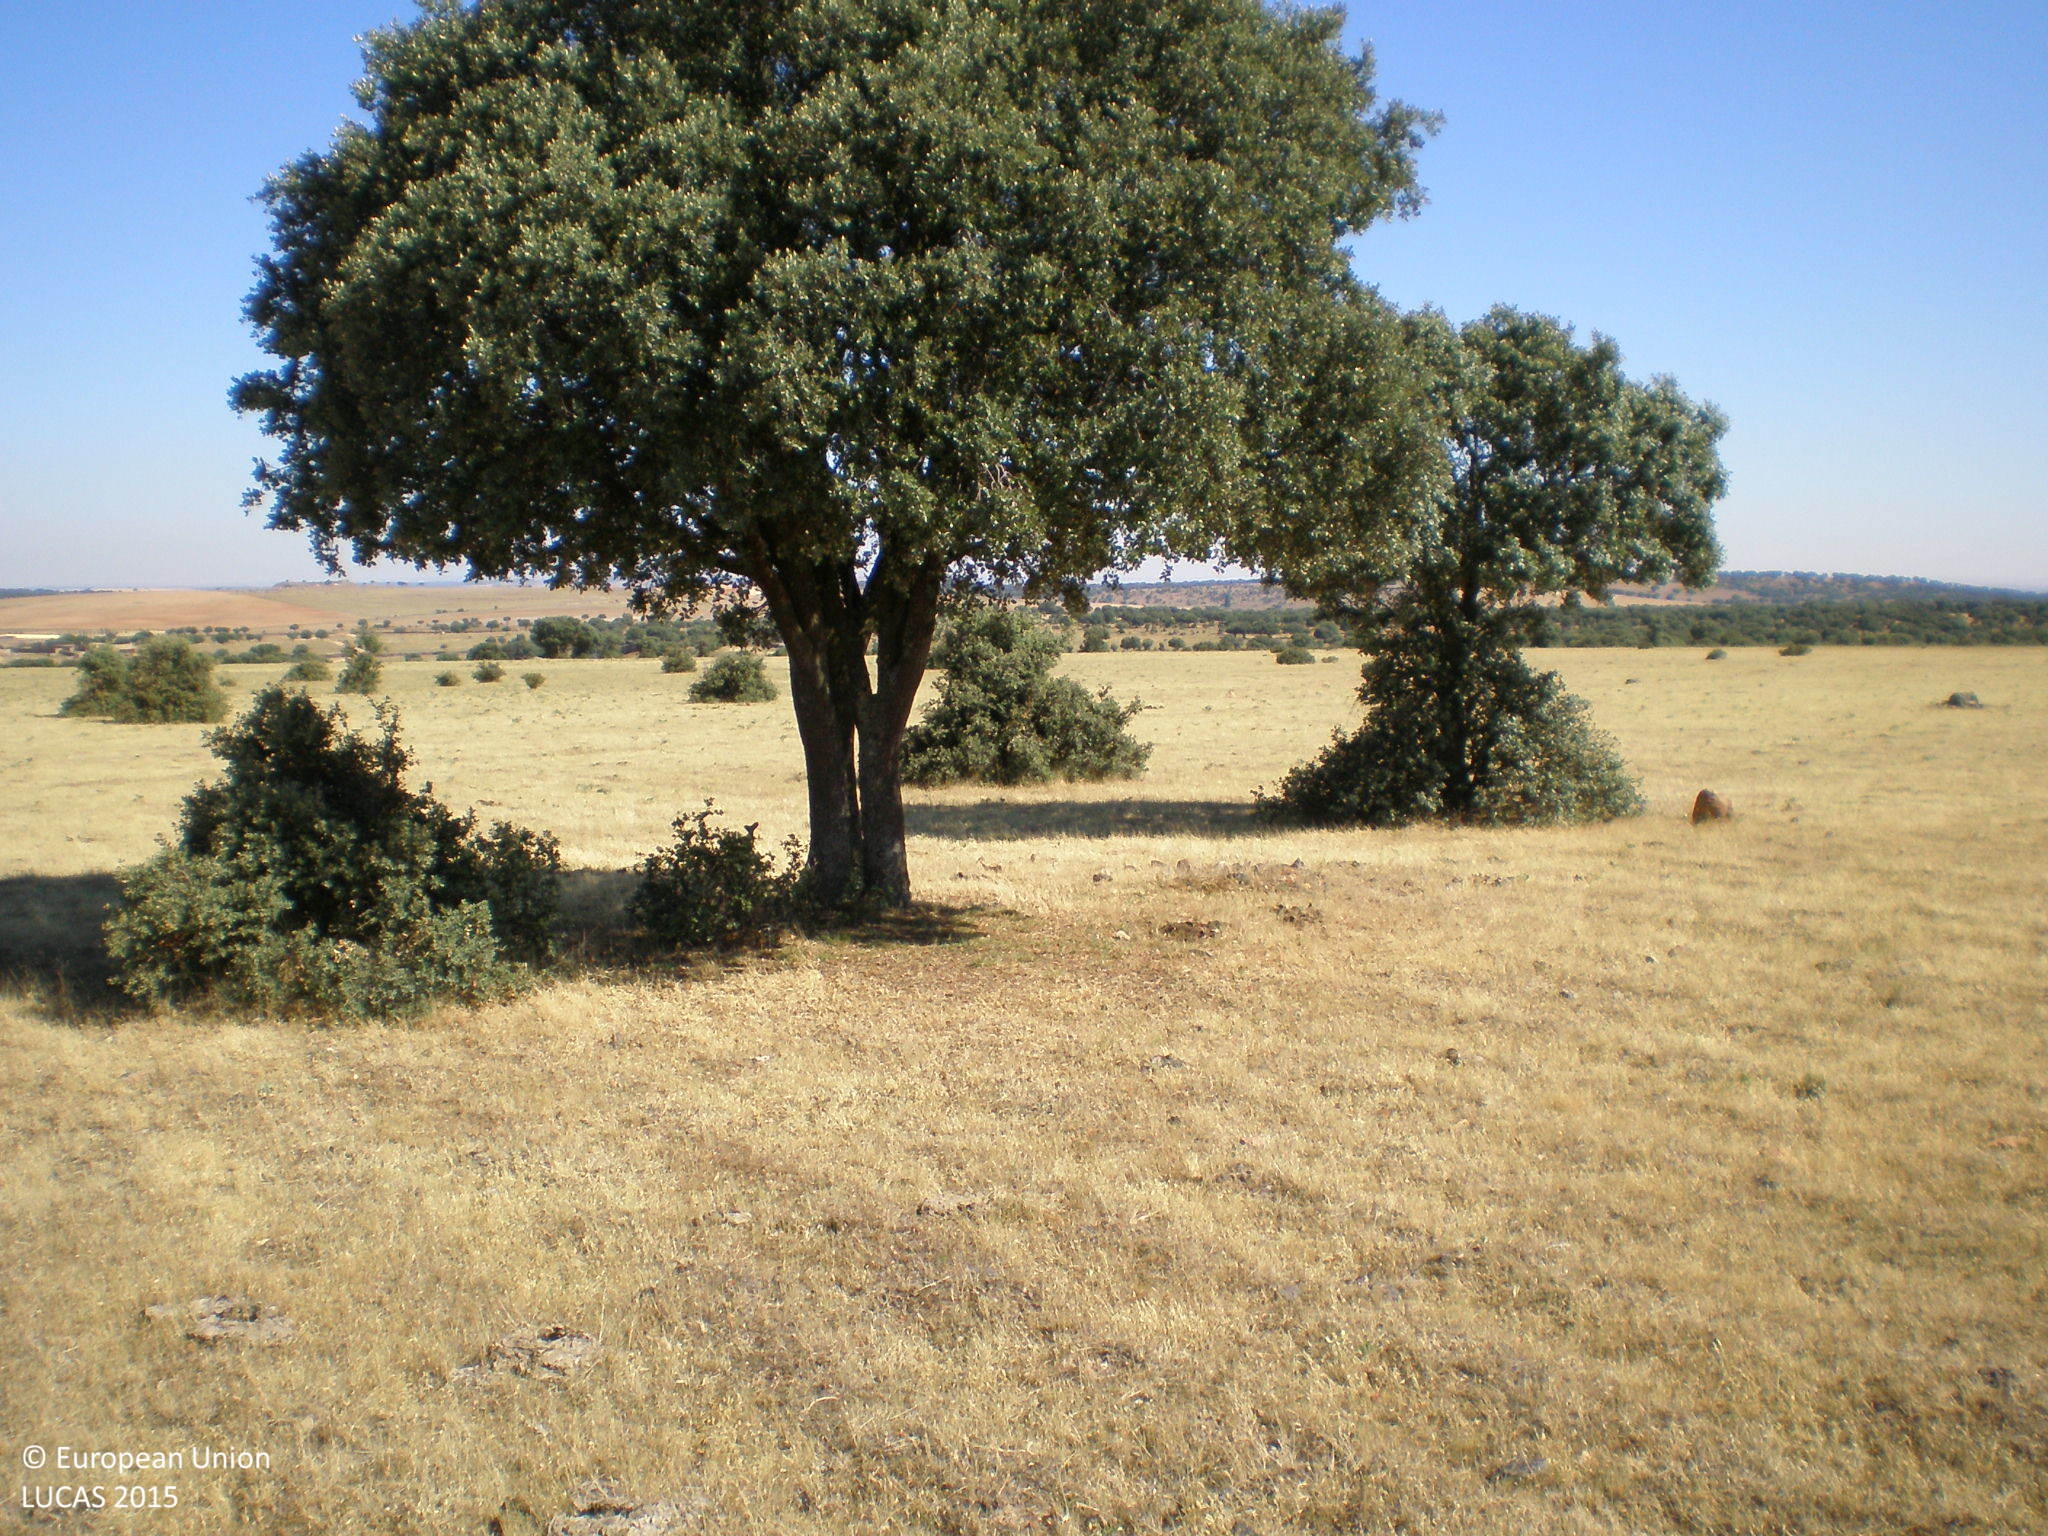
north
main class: Grassland
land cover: Grassland with sparse tree/shrub cover
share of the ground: > 75 %
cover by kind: herbaceous plants 95 %, broadleaved forest trees 5 %
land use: Agriculture (excluding fallow land and kitchen gardens)
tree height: < 5 m
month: June
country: ES
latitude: 40.7986
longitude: -5.6850
